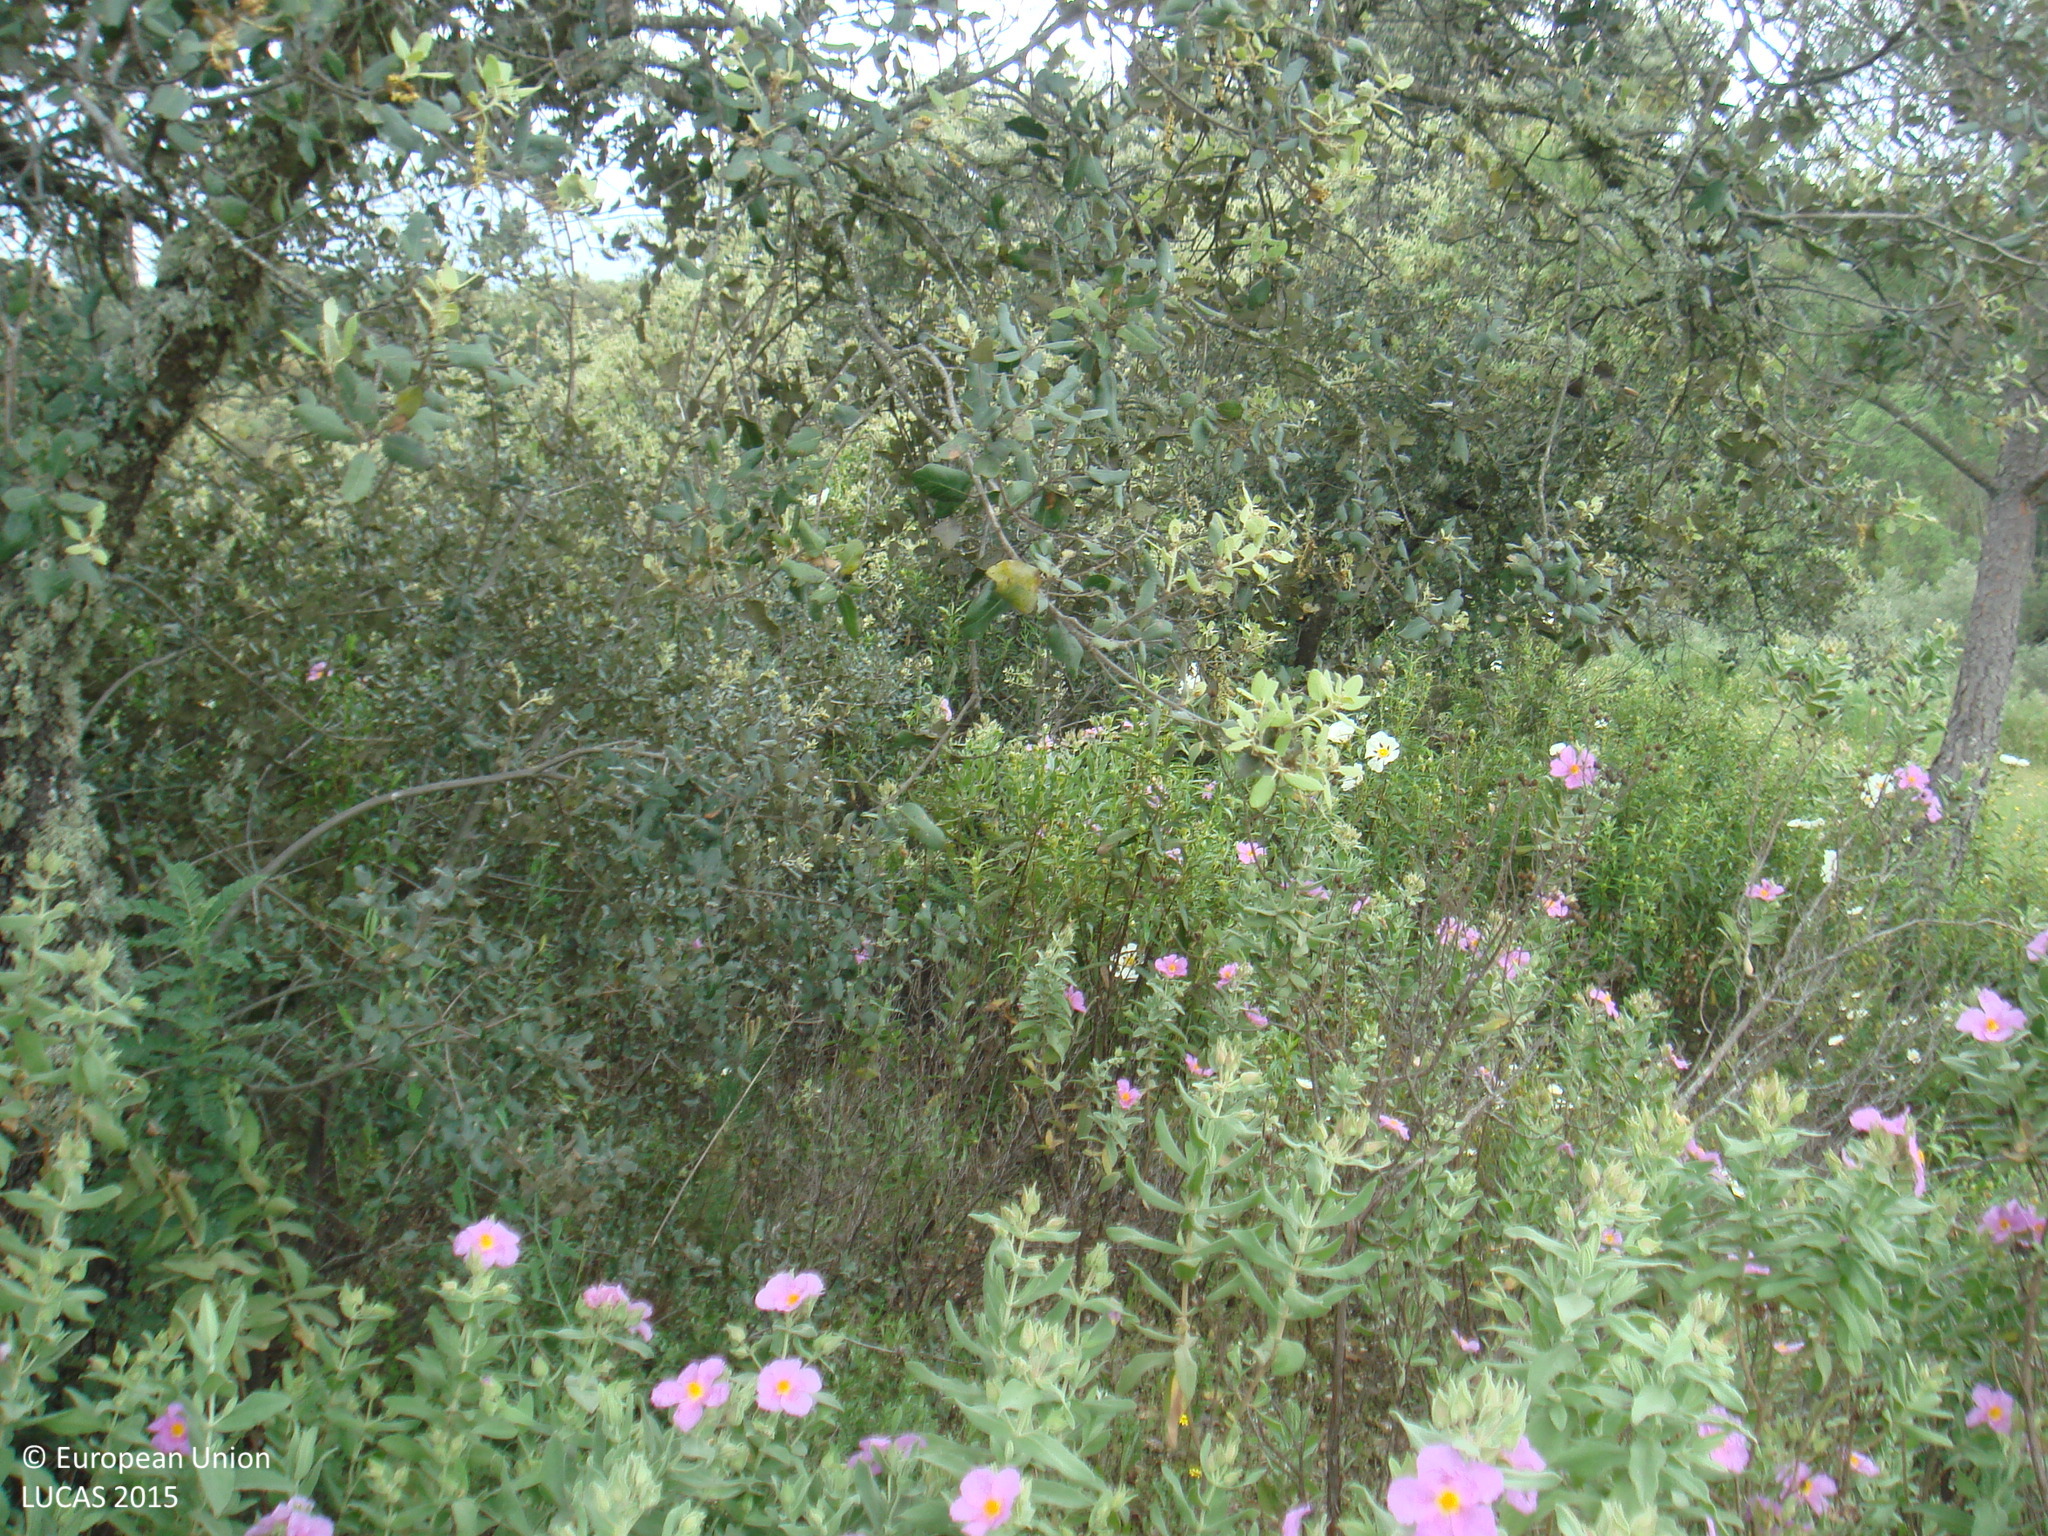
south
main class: Shrubland
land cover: Shrubland with sparse tree cover
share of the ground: > 75 %
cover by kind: shrubs 55 %, herbaceous plants 40 %, broadleaved forest trees 5 %
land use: Semi-natural and natural areas not in use
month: April
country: ES
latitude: 38.0332
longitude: -5.0481
